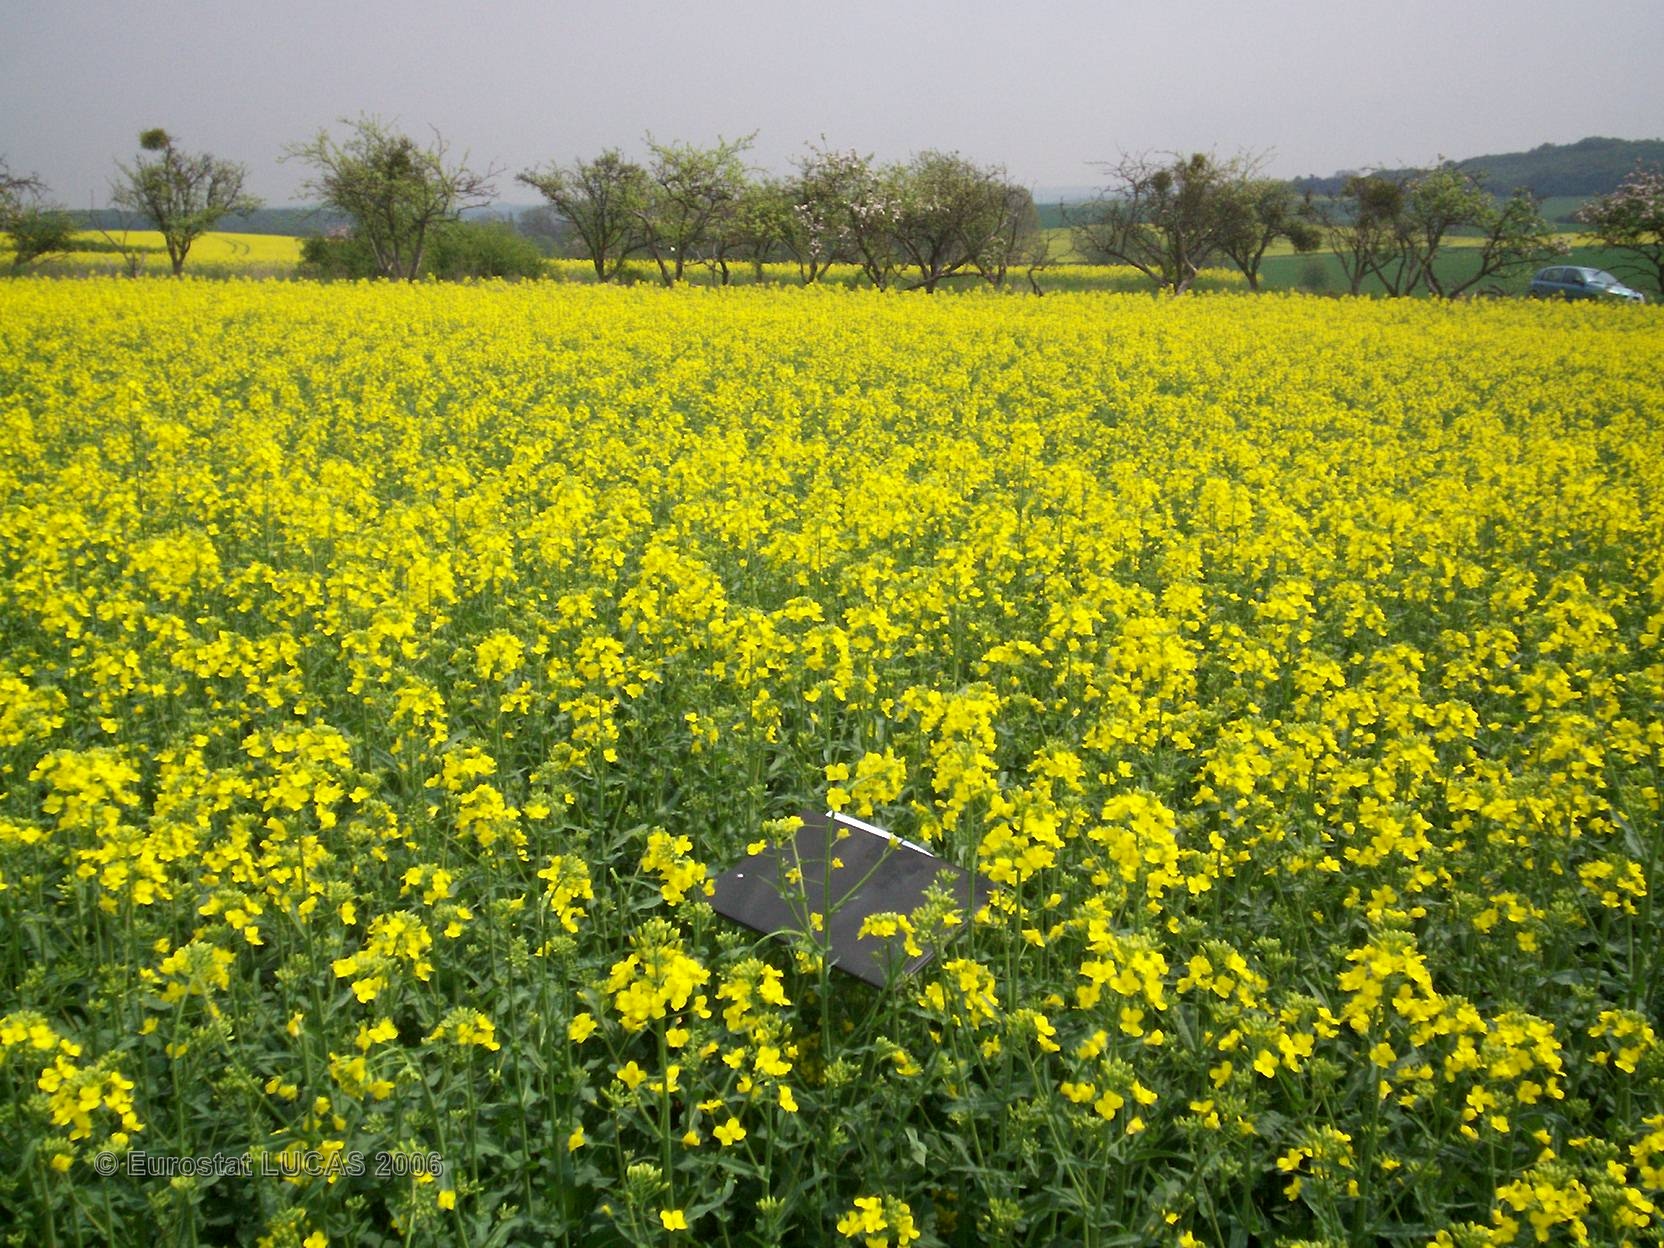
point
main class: Cropland
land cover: Rape and turnip rape
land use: Agriculture (excluding fallow land and kitchen gardens)
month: May
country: FR
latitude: 49.2278
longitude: 6.4159
